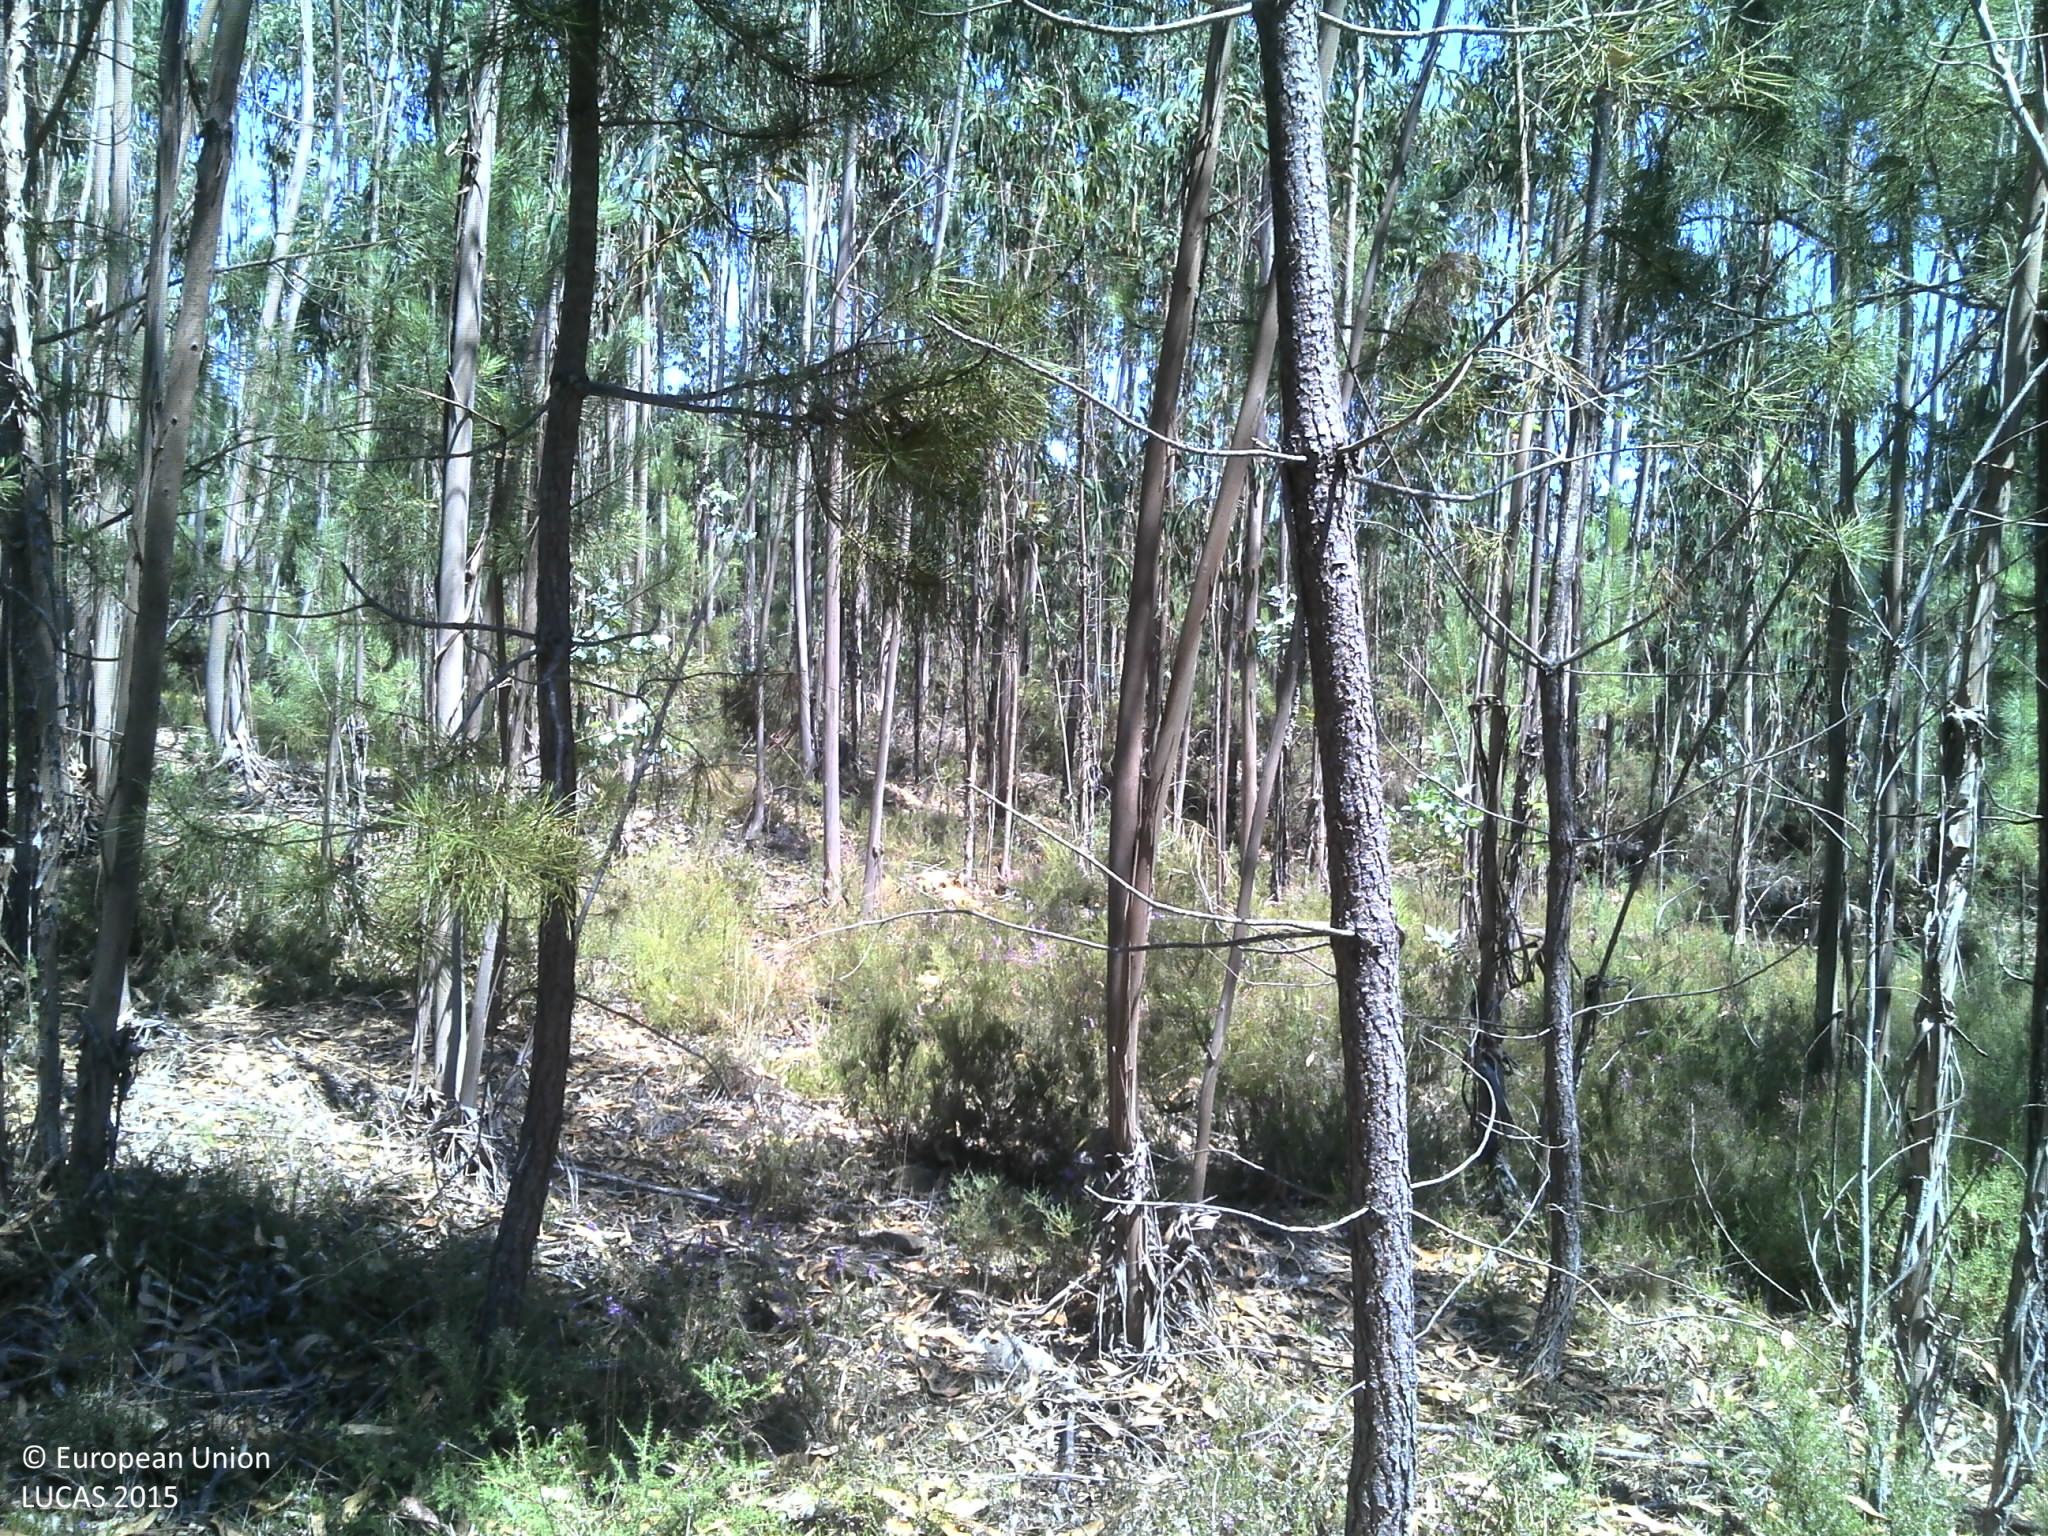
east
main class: Woodland
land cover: Broadleaved woodland
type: exotic forest
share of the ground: 25 - 50 %
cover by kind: broadleaved forest trees 50 %, shrubs 25 %, unconsolidated bare surface 20 %, coniferous forest trees 5 %
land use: Forestry
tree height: > 5 m
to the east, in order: Broadleaved woodland; Tracks; Broadleaved woodland; Tracks; Broadleaved woodland; Shrubland without tree cover
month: July
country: PT
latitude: 40.4344
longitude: -8.1997
